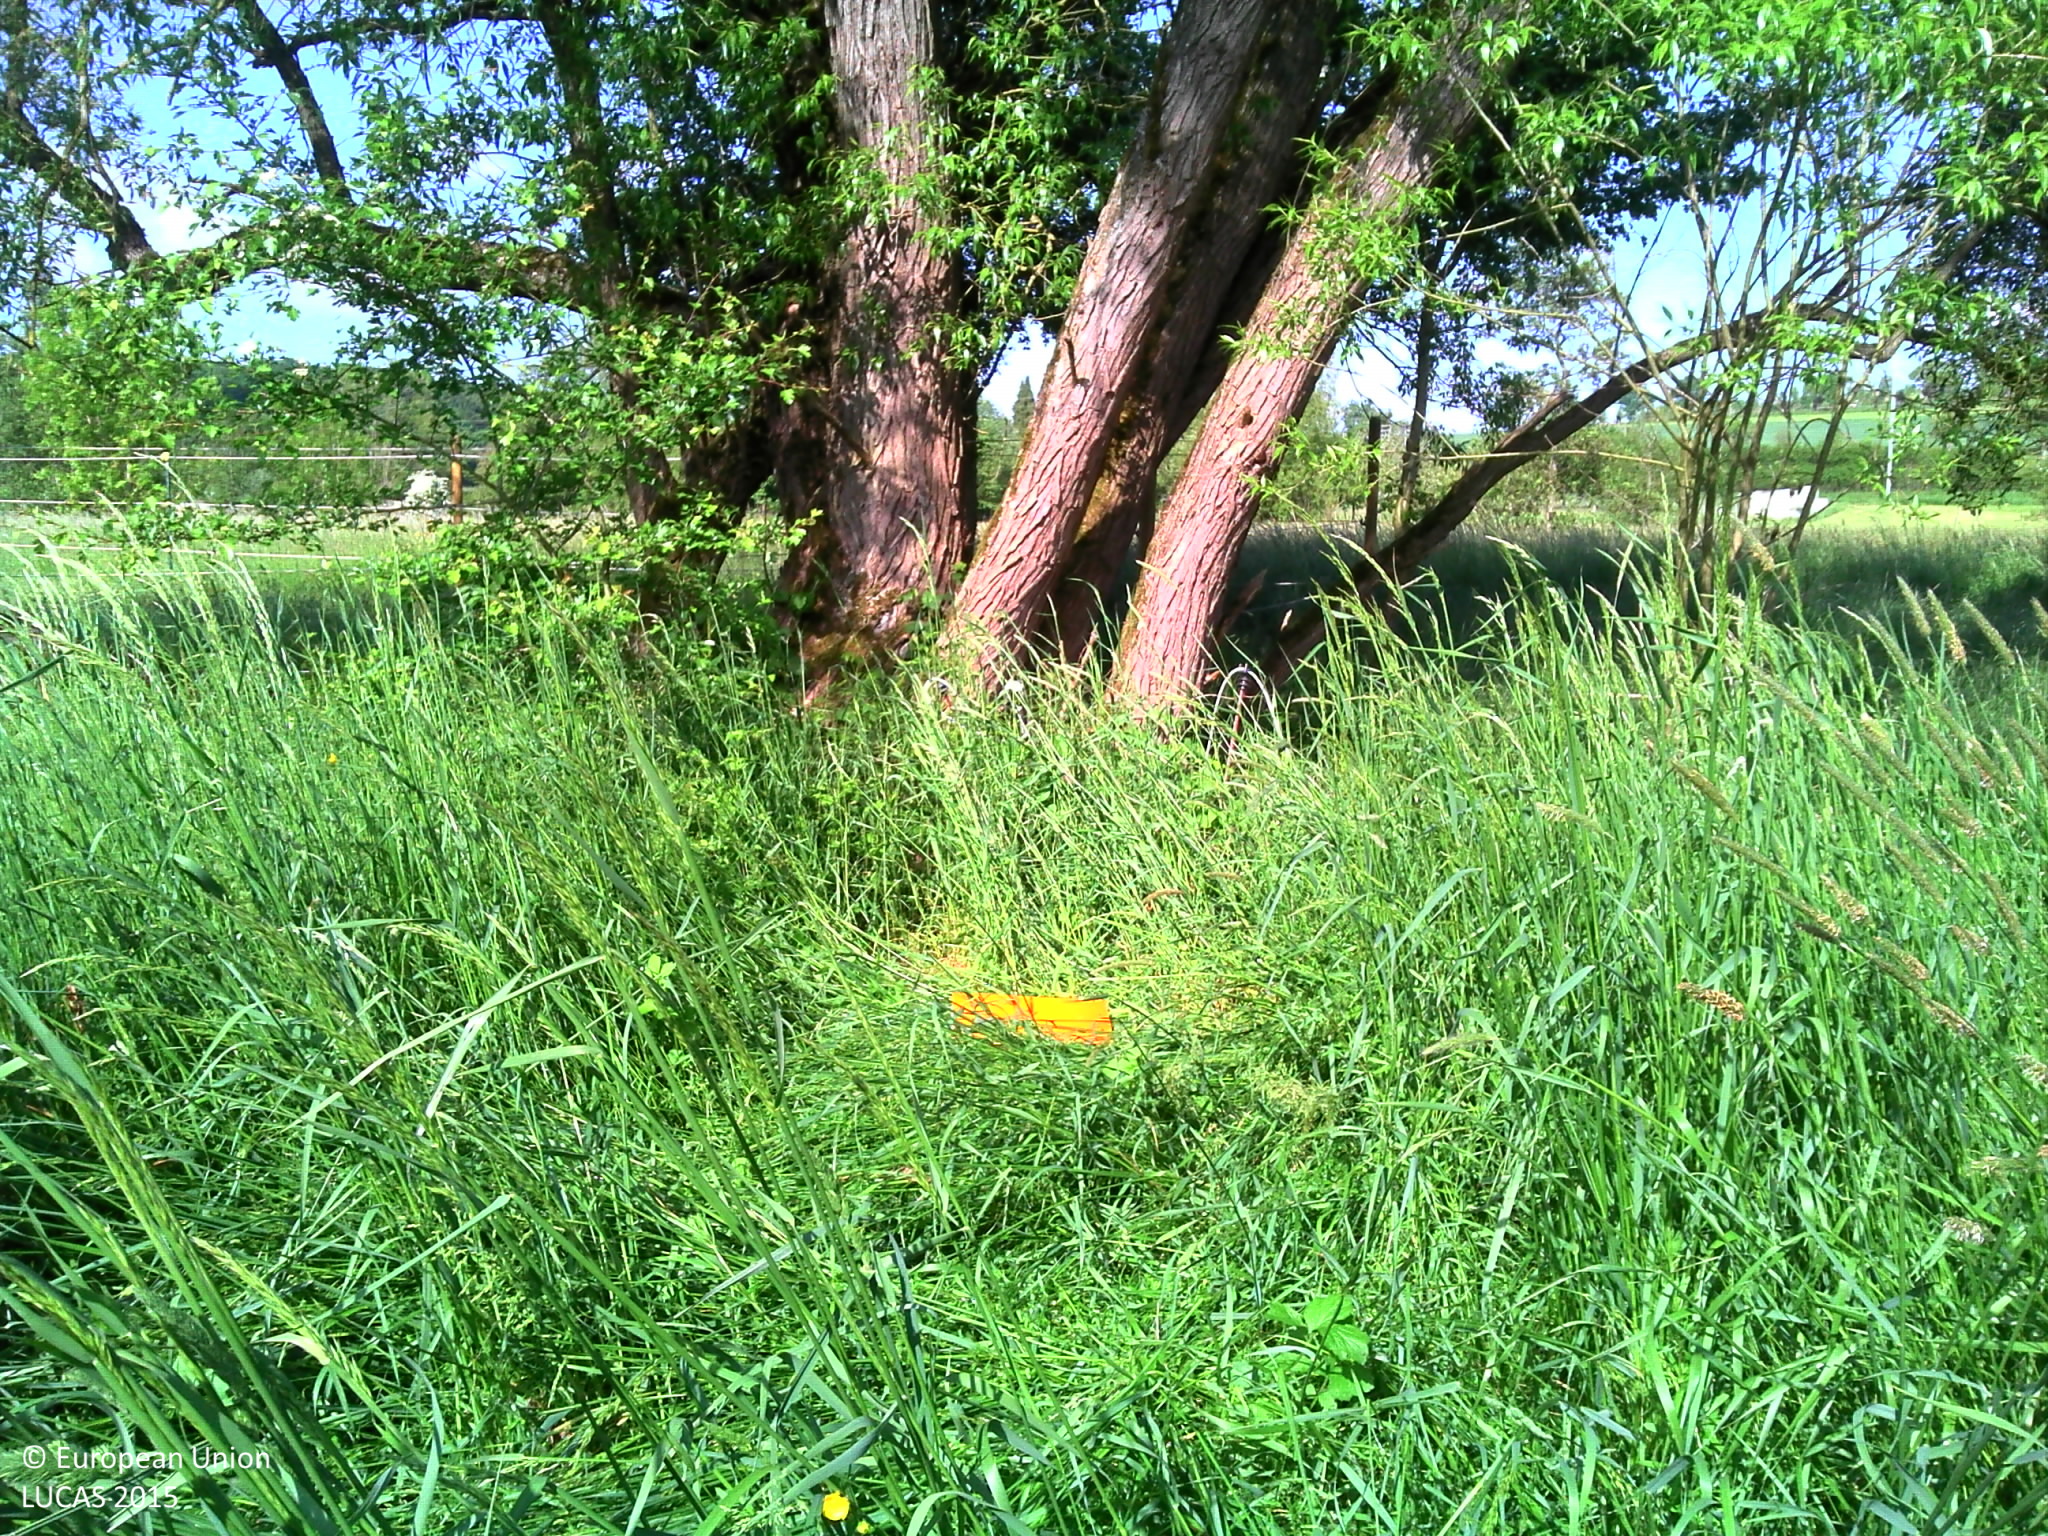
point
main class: Woodland
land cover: Broadleaved woodland
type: floodplain forest
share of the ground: > 75 %
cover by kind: broadleaved forest trees 80 %, herbaceous plants 15 %, shrubs 5 %
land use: Agriculture (excluding fallow land and kitchen gardens)
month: May
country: LU
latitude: 49.6562
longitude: 6.3010
